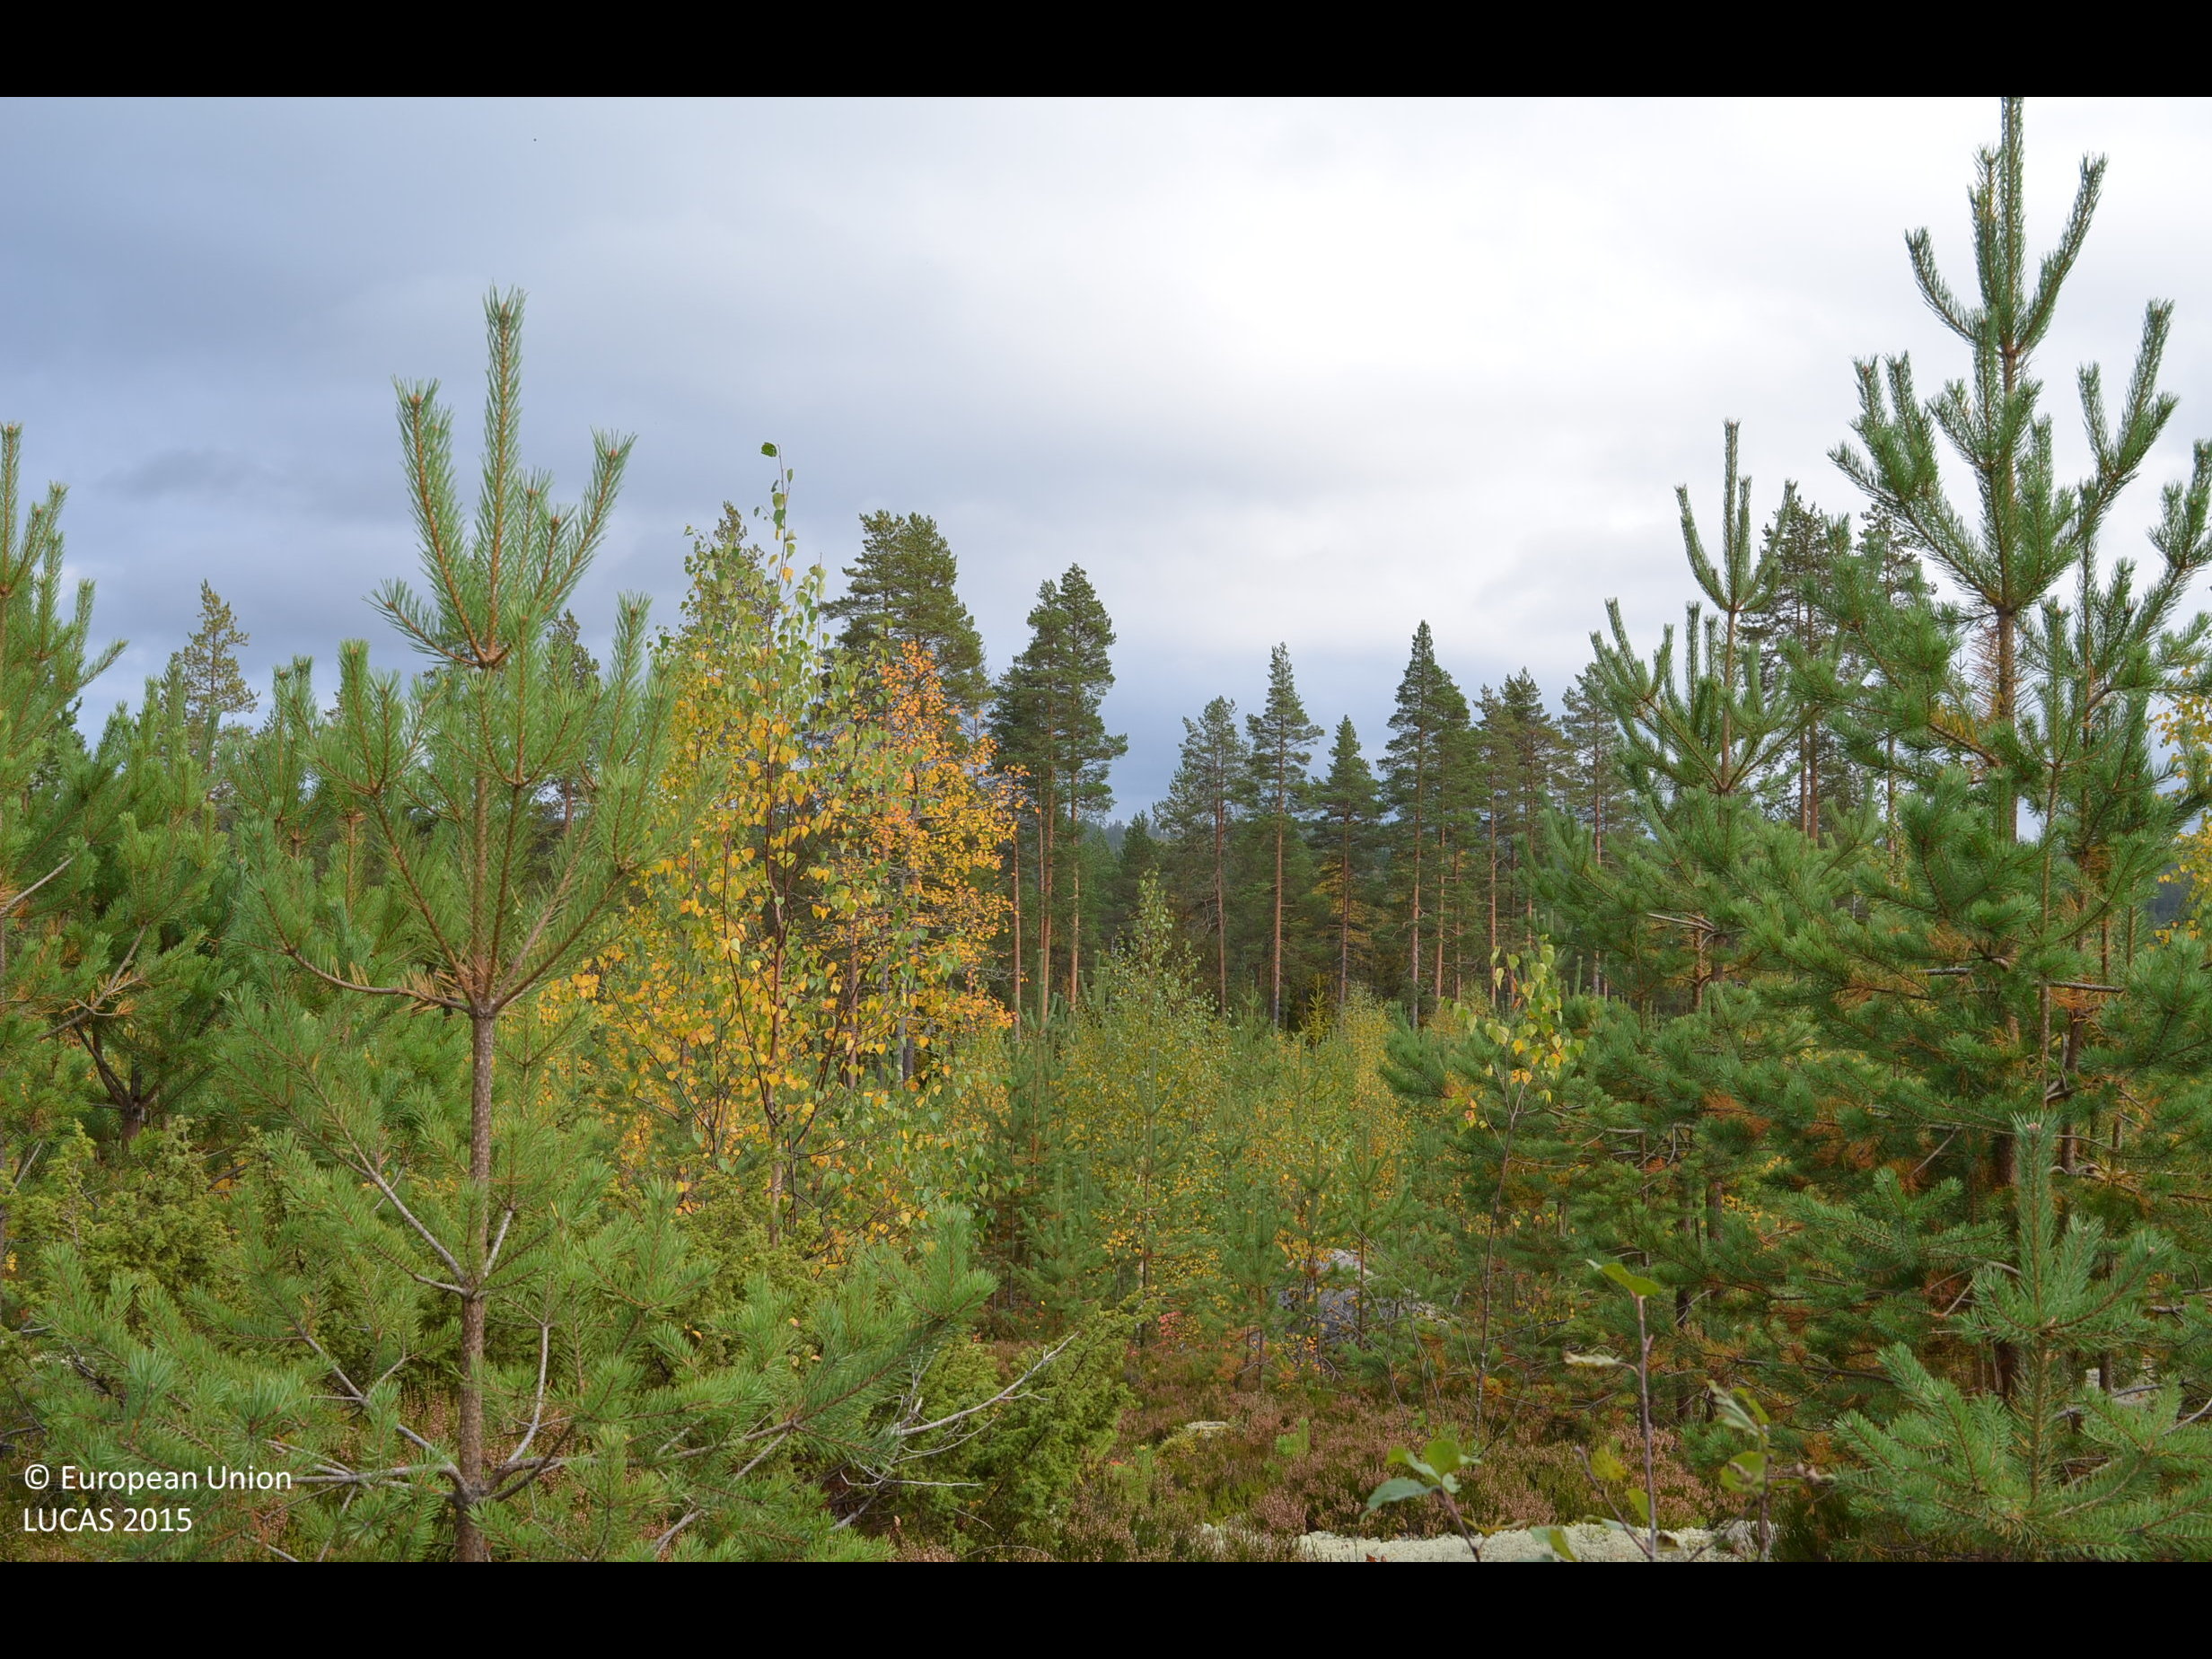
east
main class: Woodland
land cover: Pine dominated mixed woodland
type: boreal forest
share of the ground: 50 - 75 %
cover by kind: coniferous forest trees 35 %, shrubs 30 %, broadleaved forest trees 25 %, lichens and mosses 10 %
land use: Forestry
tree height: < 5 m
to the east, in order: Pine dominated mixed woodland; Other mixed woodland; Ditches and canals; Pine dominated coniferous woodland; Ditches and canals; Pine dominated coniferous woodland; Ditches and canals; Pine dominated coniferous woodland; Shrubland without tree cover; Electric lines; Shrubland without tree cover; Pine dominated mixed woodland; Ditches and canals; Pine dominated mixed woodland
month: September
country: FI
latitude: 62.7269
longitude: 23.7865
